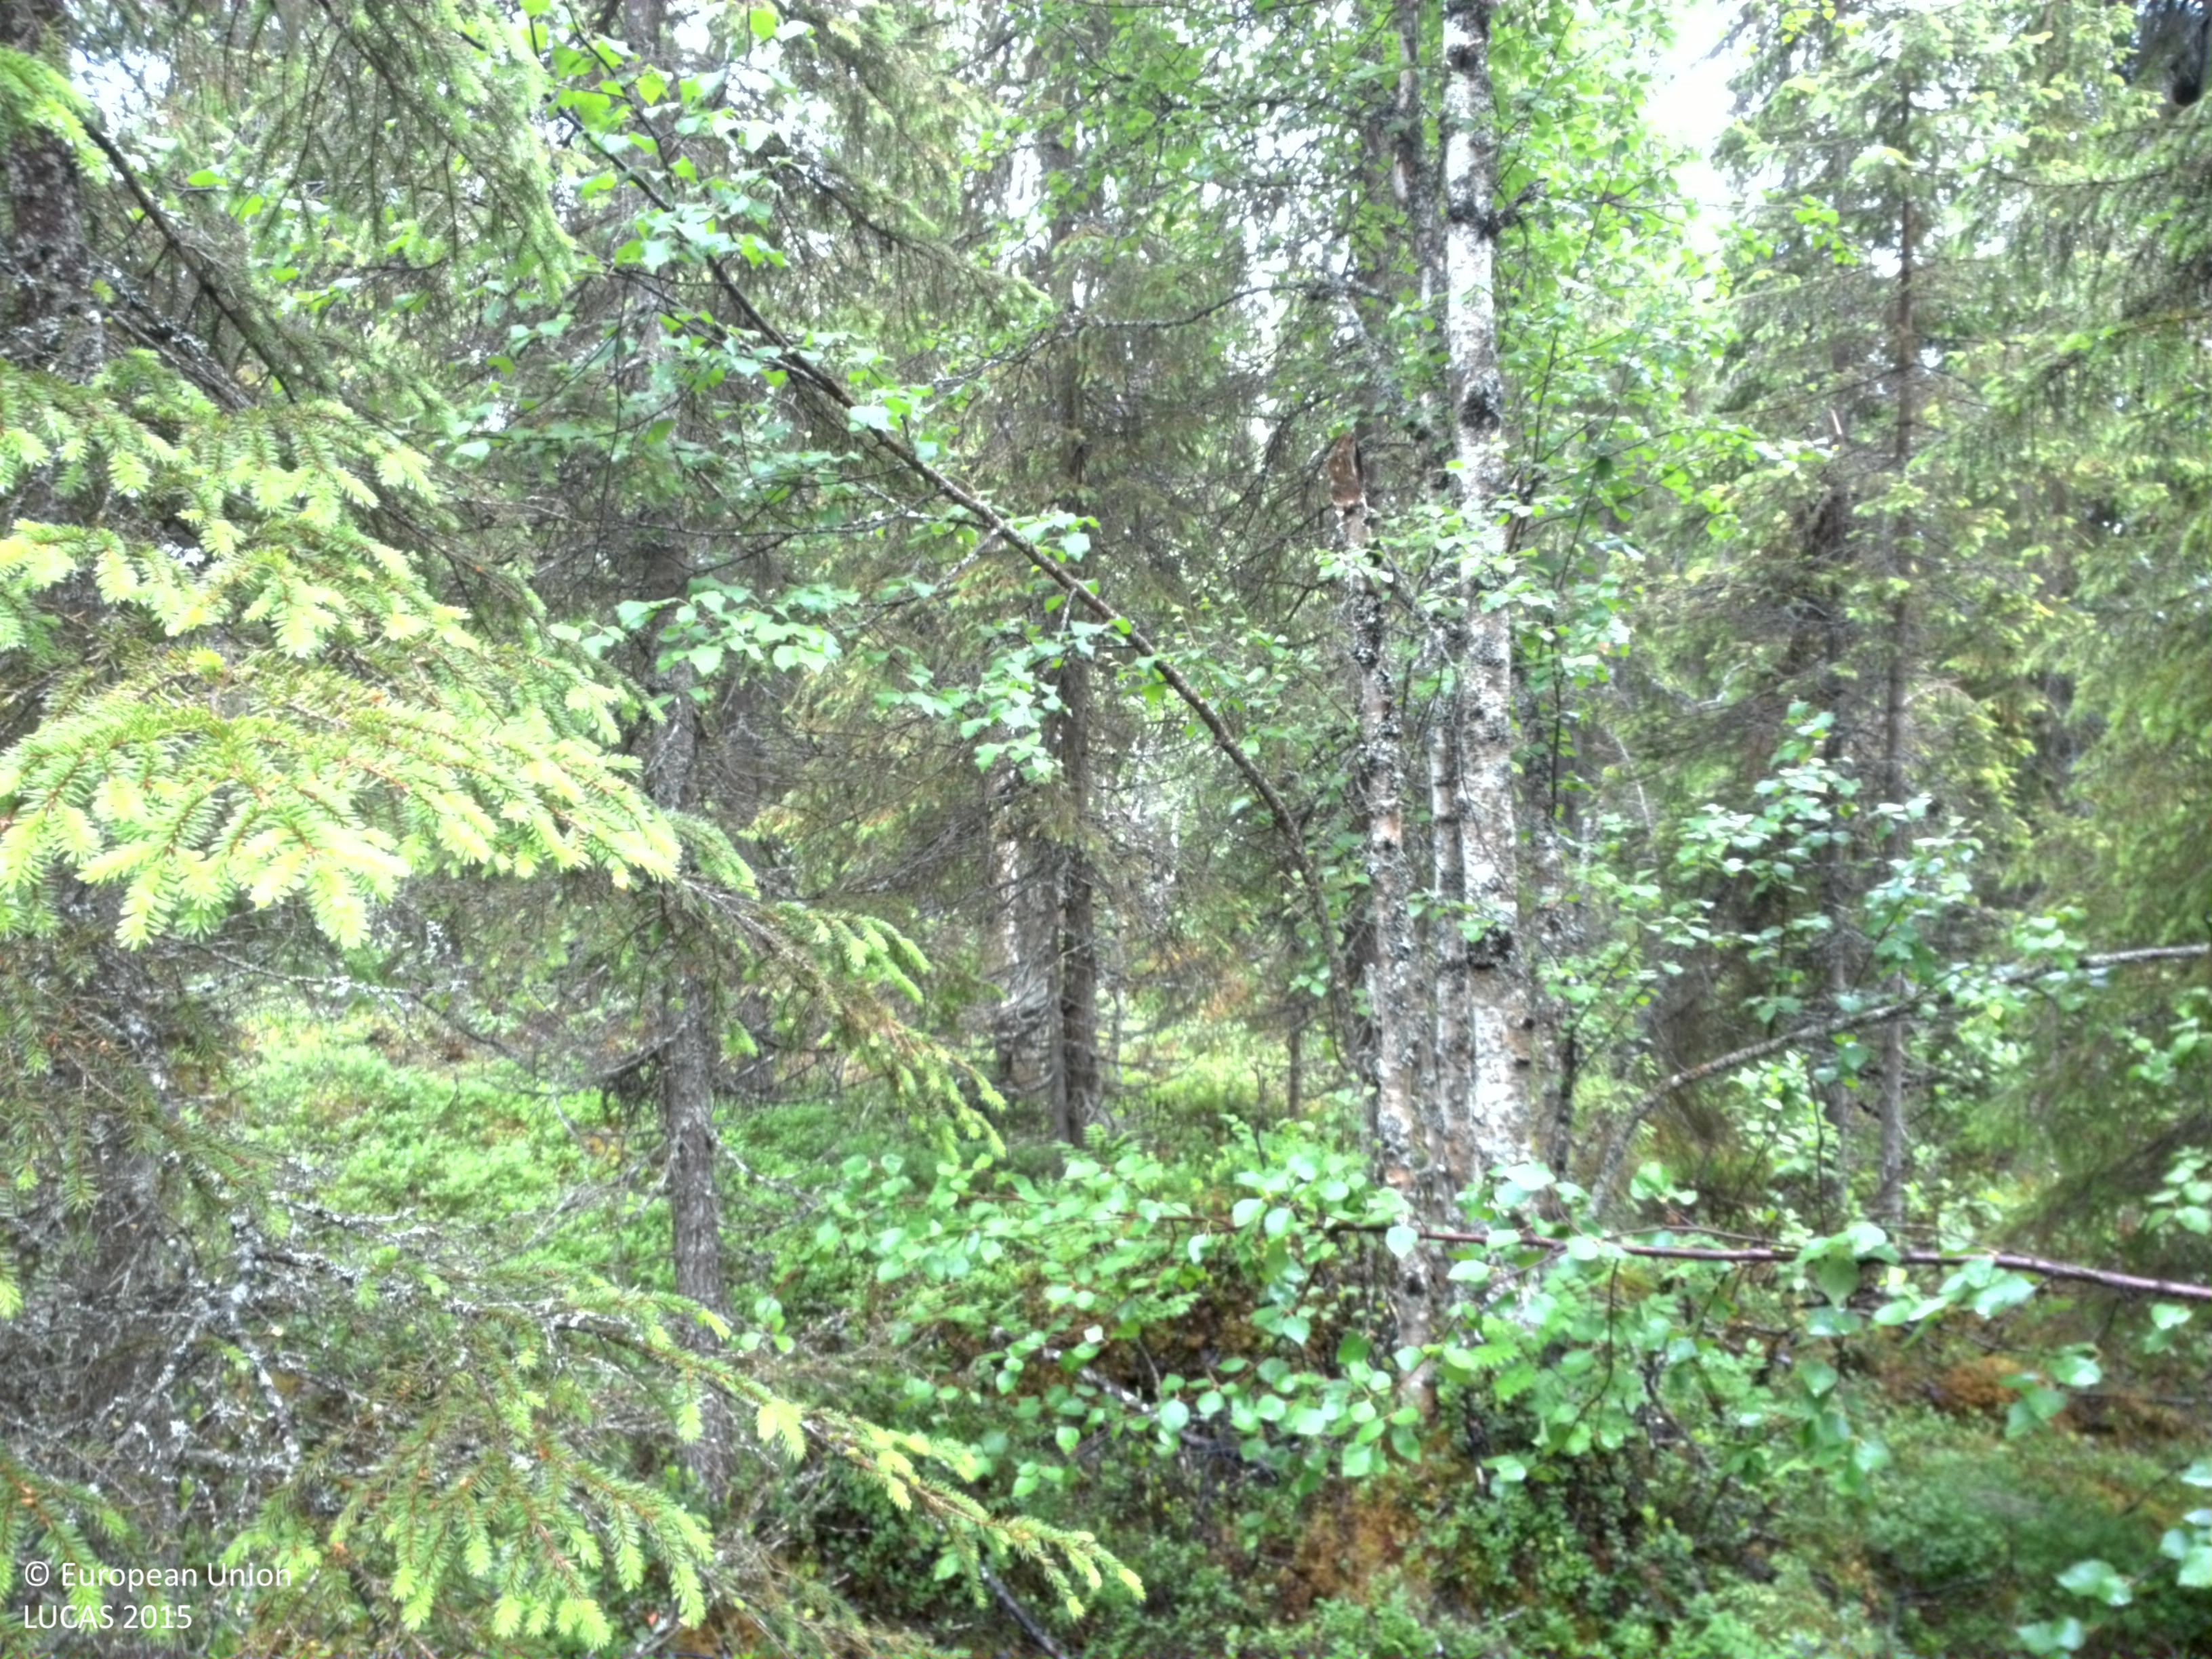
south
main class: Woodland
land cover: Spruce dominated mixed woodland
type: boreal forest
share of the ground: 50 - 75 %
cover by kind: shrubs 35 %, coniferous forest trees 25 %, broadleaved forest trees 25 %, lichens and mosses 10 %, herbaceous plants 5 %
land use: Amenities, museums, leisure
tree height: > 5 m
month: July
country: SE
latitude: 65.4717
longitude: 16.2444
